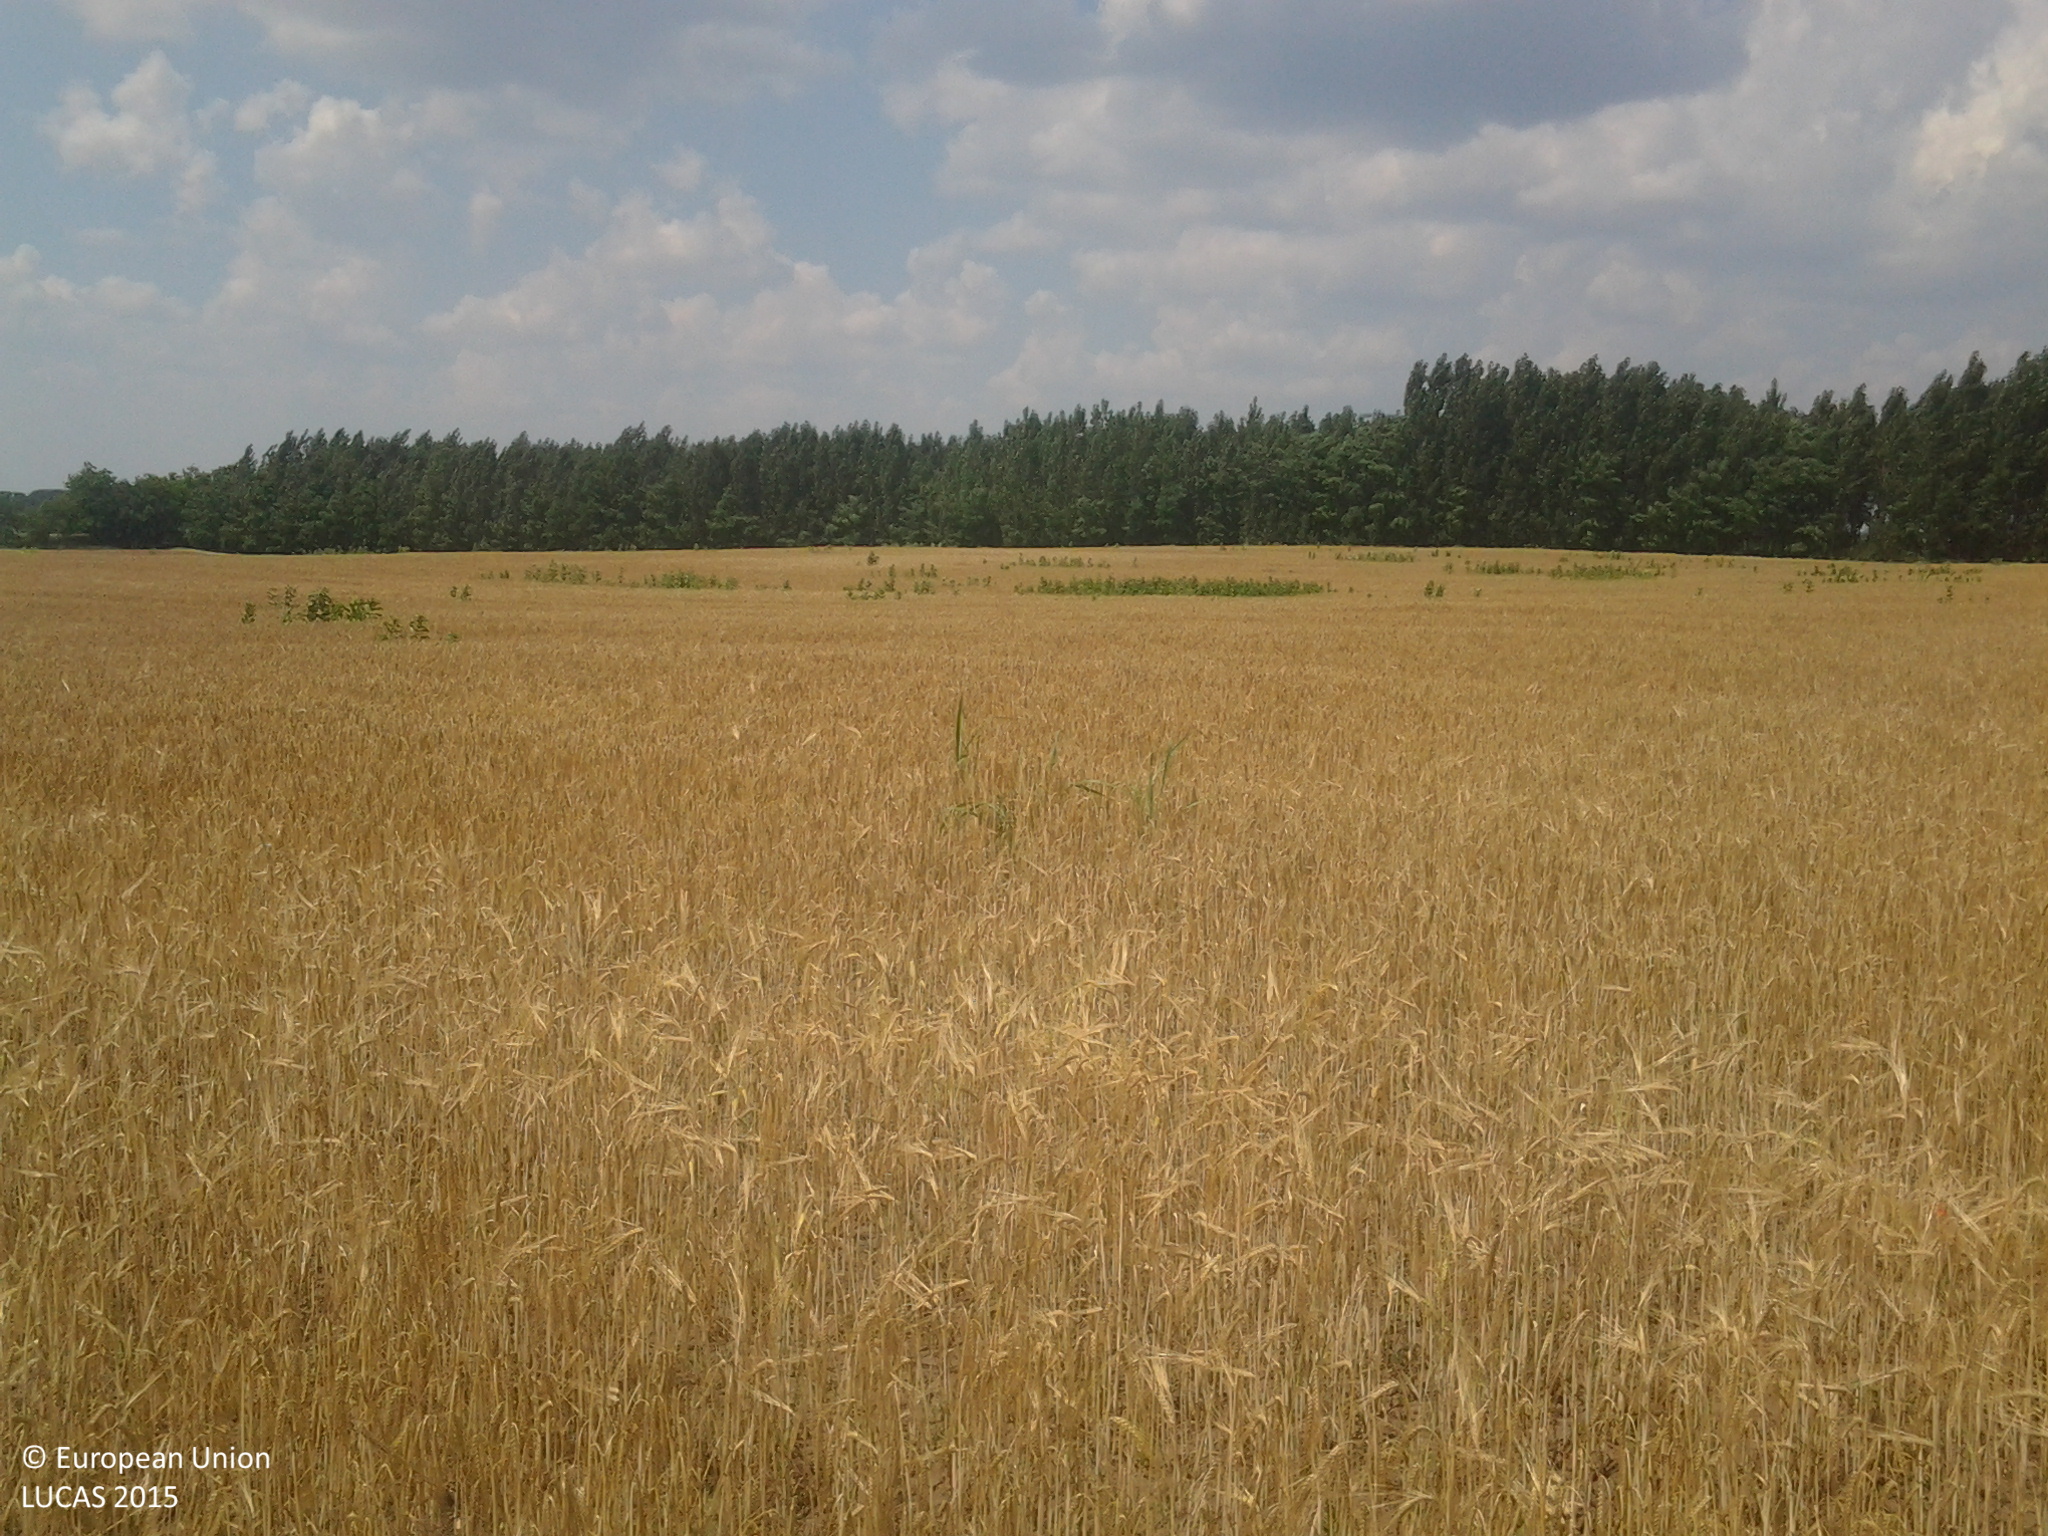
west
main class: Cropland
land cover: Barley
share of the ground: > 75 %
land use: Agriculture (excluding fallow land and kitchen gardens)
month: June
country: HU
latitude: 46.8155
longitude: 19.7059
